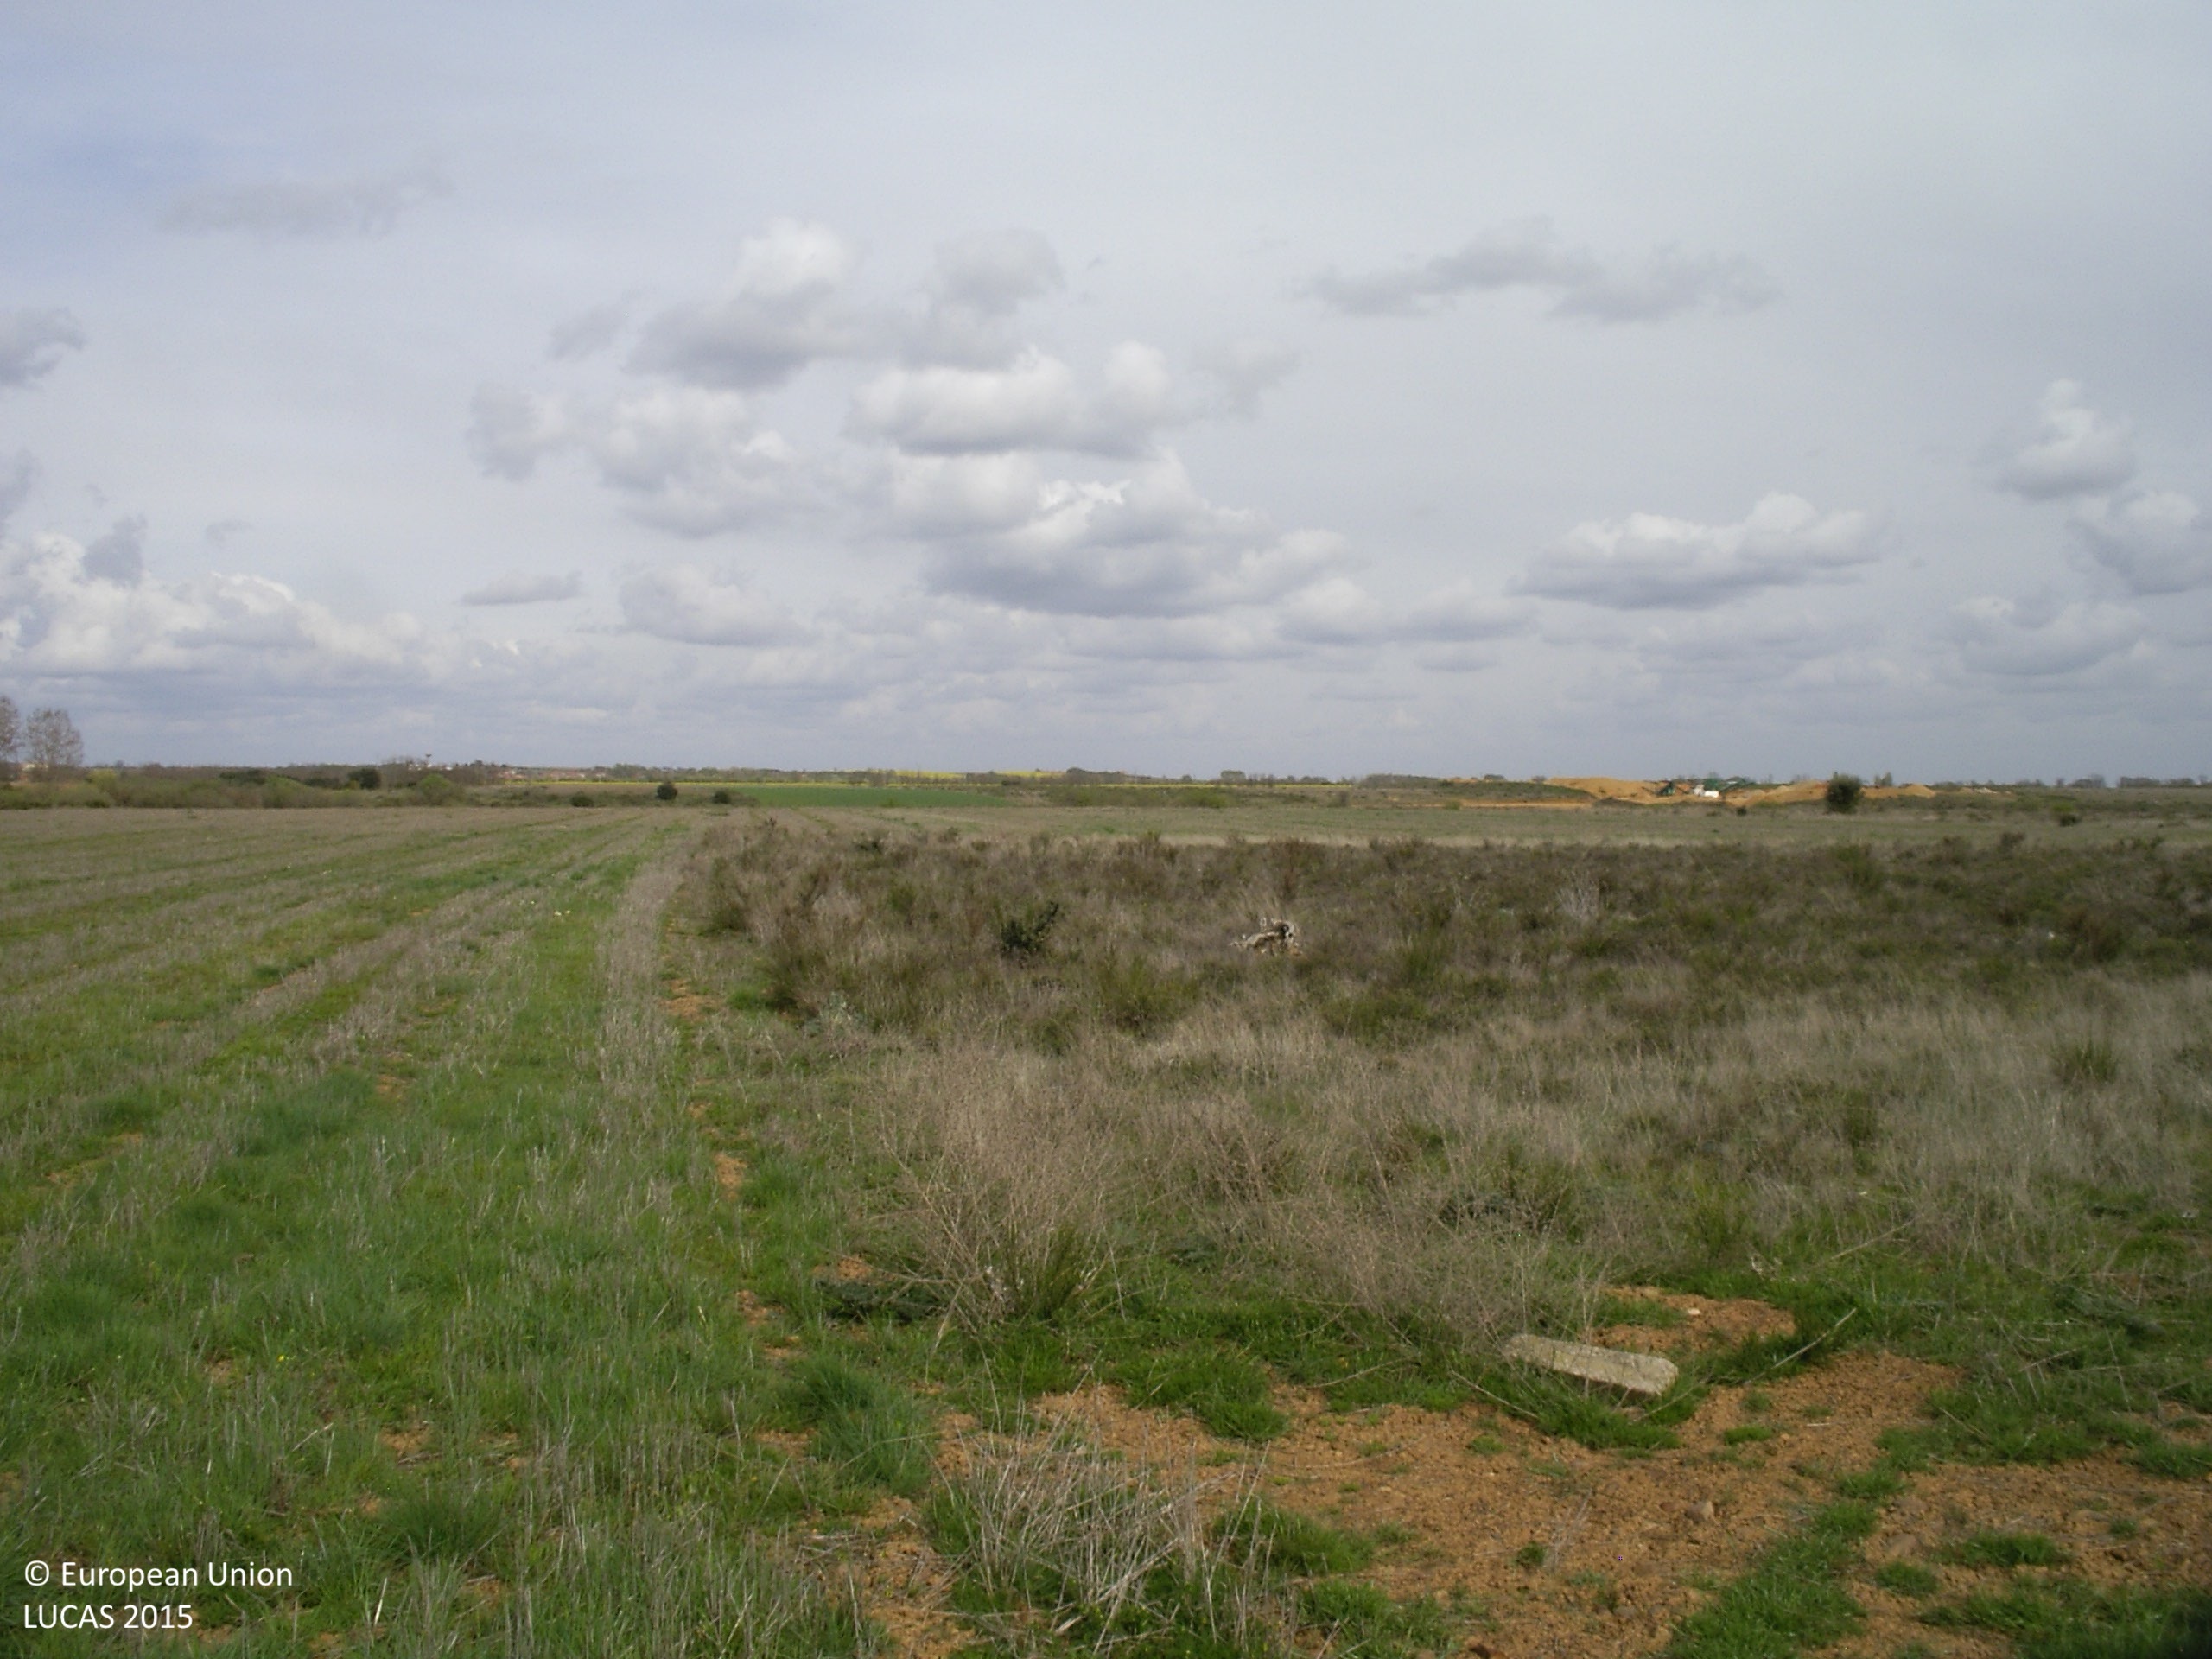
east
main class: Grassland
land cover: Spontaneously vegetated surfaces
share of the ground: > 75 %
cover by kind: herbaceous plants 95 %, shrubs 5 %
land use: Fallow land
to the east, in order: Spontaneously vegetated surfaces; Shrubland without tree cover; Spontaneously vegetated surfaces; Grassland without tree/shrub cover; Shrubland without tree cover
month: April
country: ES
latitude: 42.5161
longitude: -5.7403
